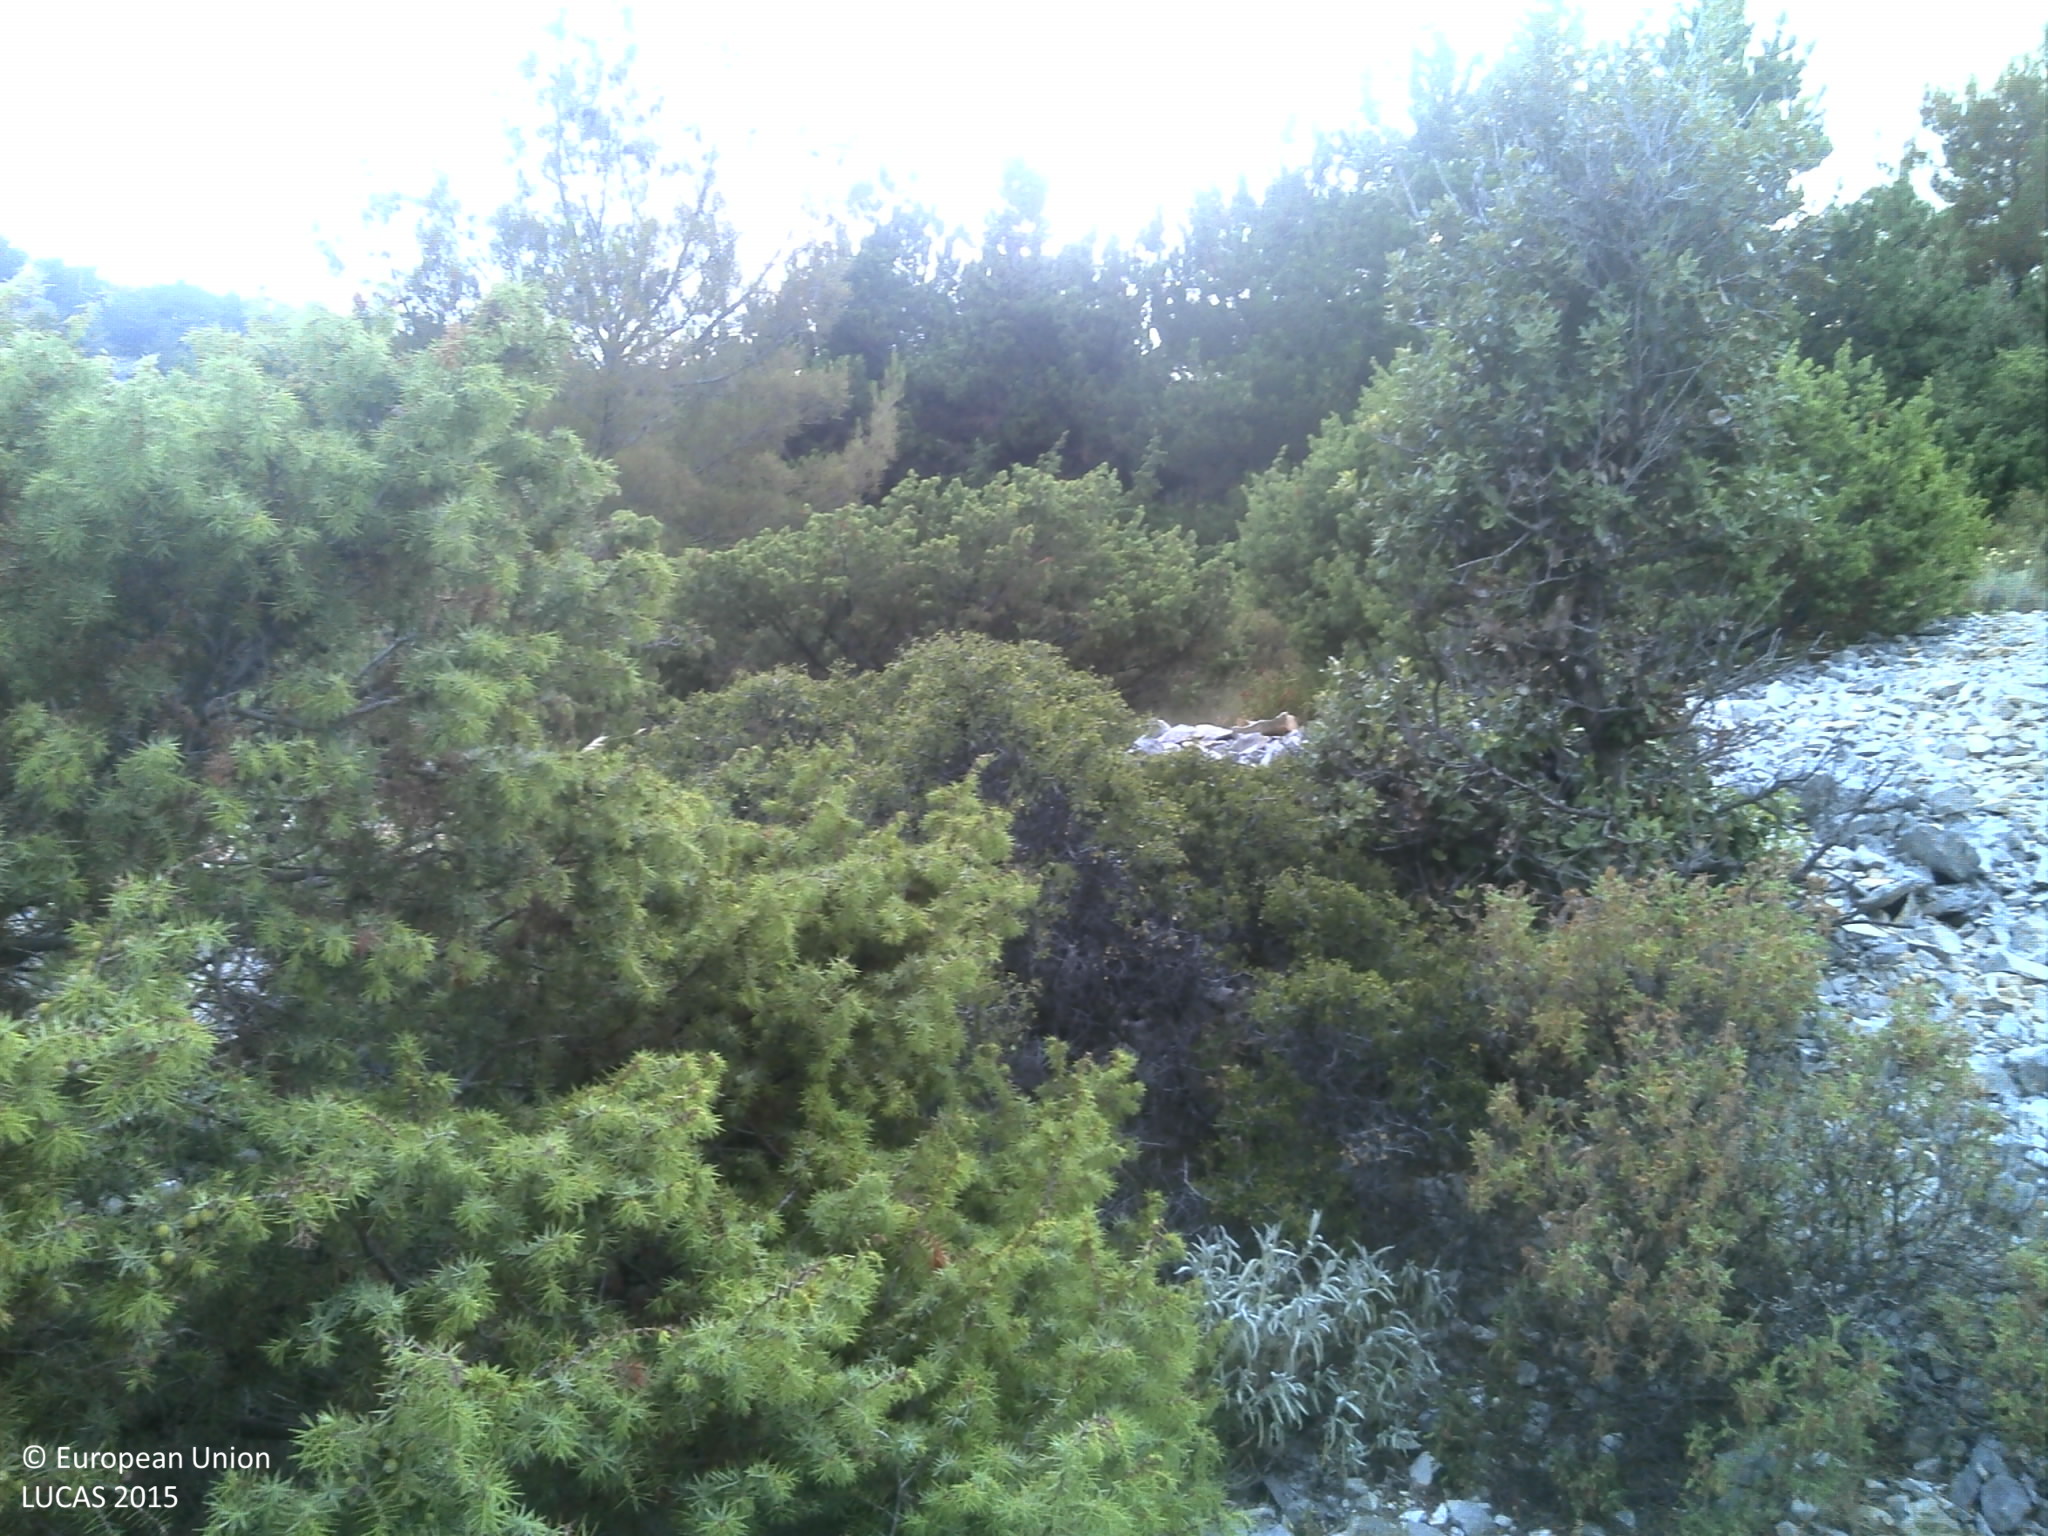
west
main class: Shrubland
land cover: Shrubland with sparse tree cover
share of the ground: > 75 %
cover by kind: shrubs 50 %, unconsolidated bare surface 25 %, consolidated bare surface 15 %, coniferous forest trees 5 %, herbaceous plants 5 %
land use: Semi-natural and natural areas not in use
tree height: < 5 m
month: July
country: HR
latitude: 43.3268
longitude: 16.5880
